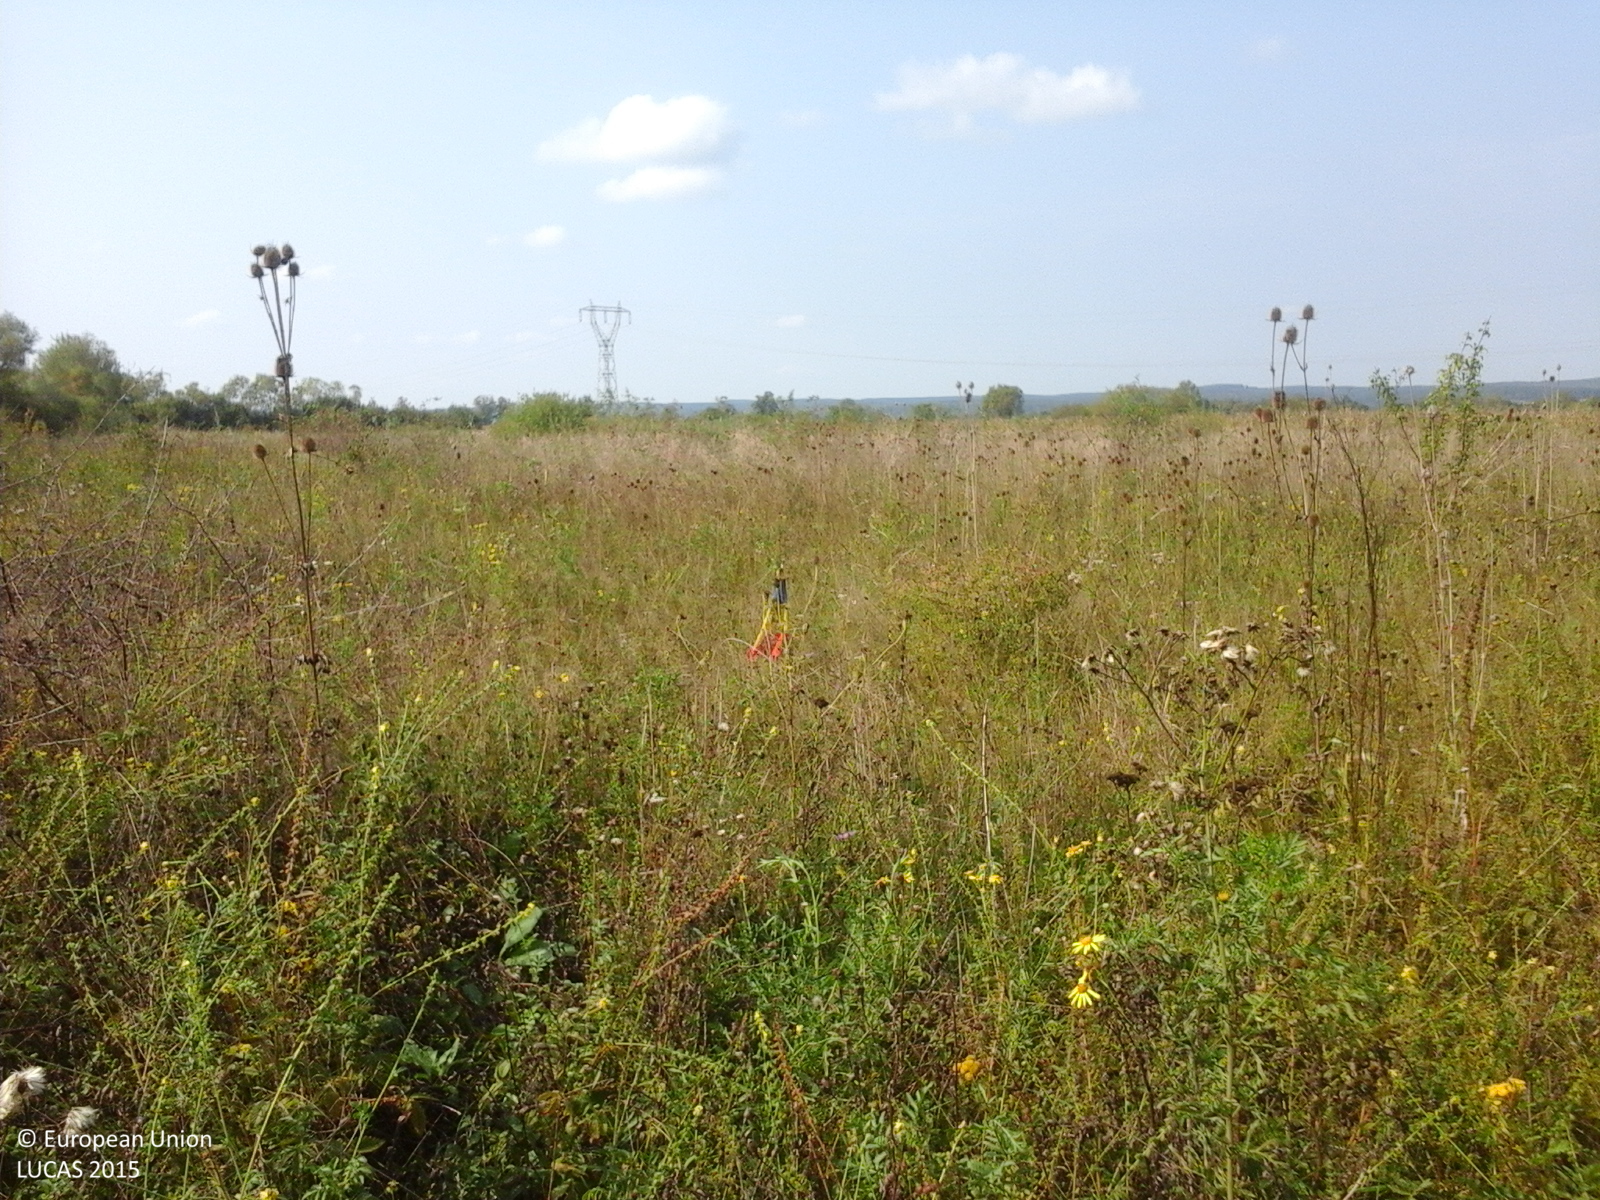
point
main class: Grassland
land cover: Spontaneously vegetated surfaces
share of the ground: > 75 %
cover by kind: herbaceous plants 100 %
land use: Fallow land
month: September
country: RO
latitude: 45.8398
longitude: 22.2889
